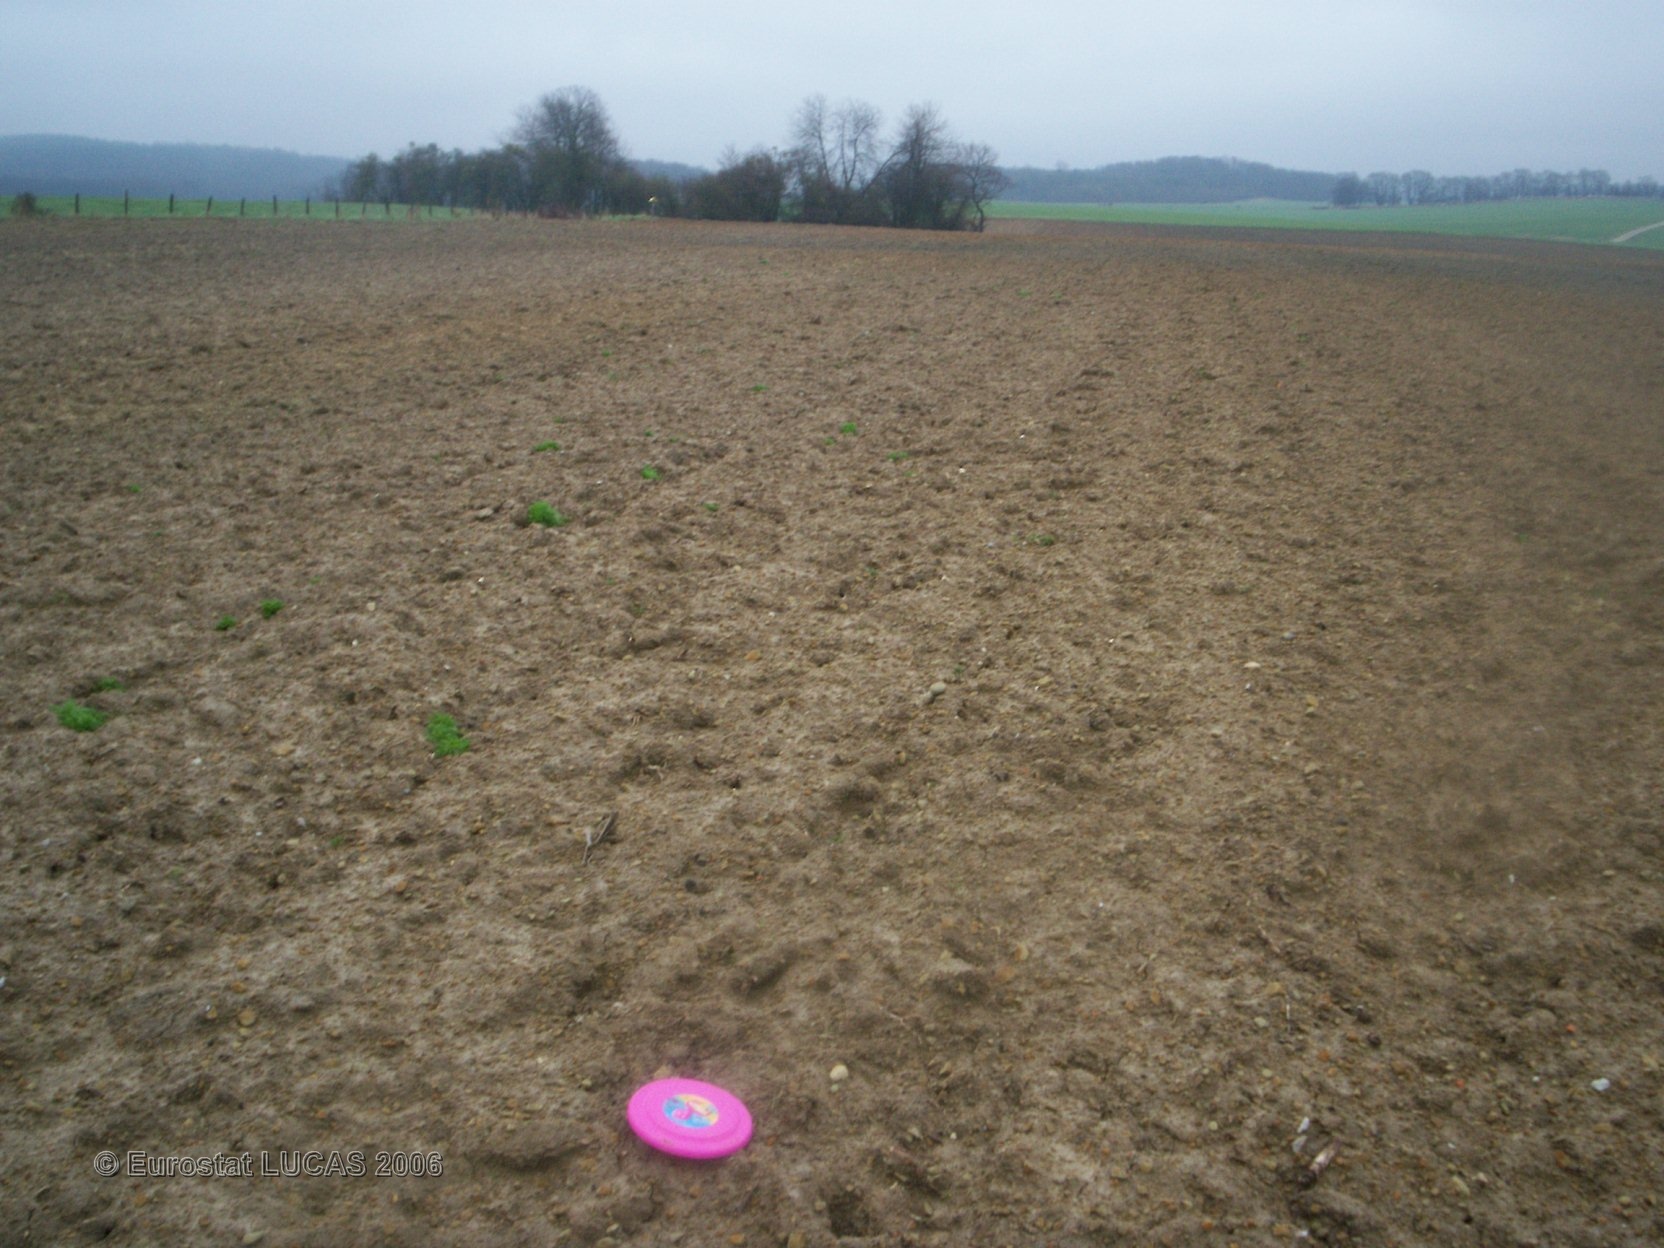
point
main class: Cropland
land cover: Maize
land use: Agriculture (excluding fallow land and kitchen gardens)
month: June
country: FR
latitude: 49.1589
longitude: 5.0751
